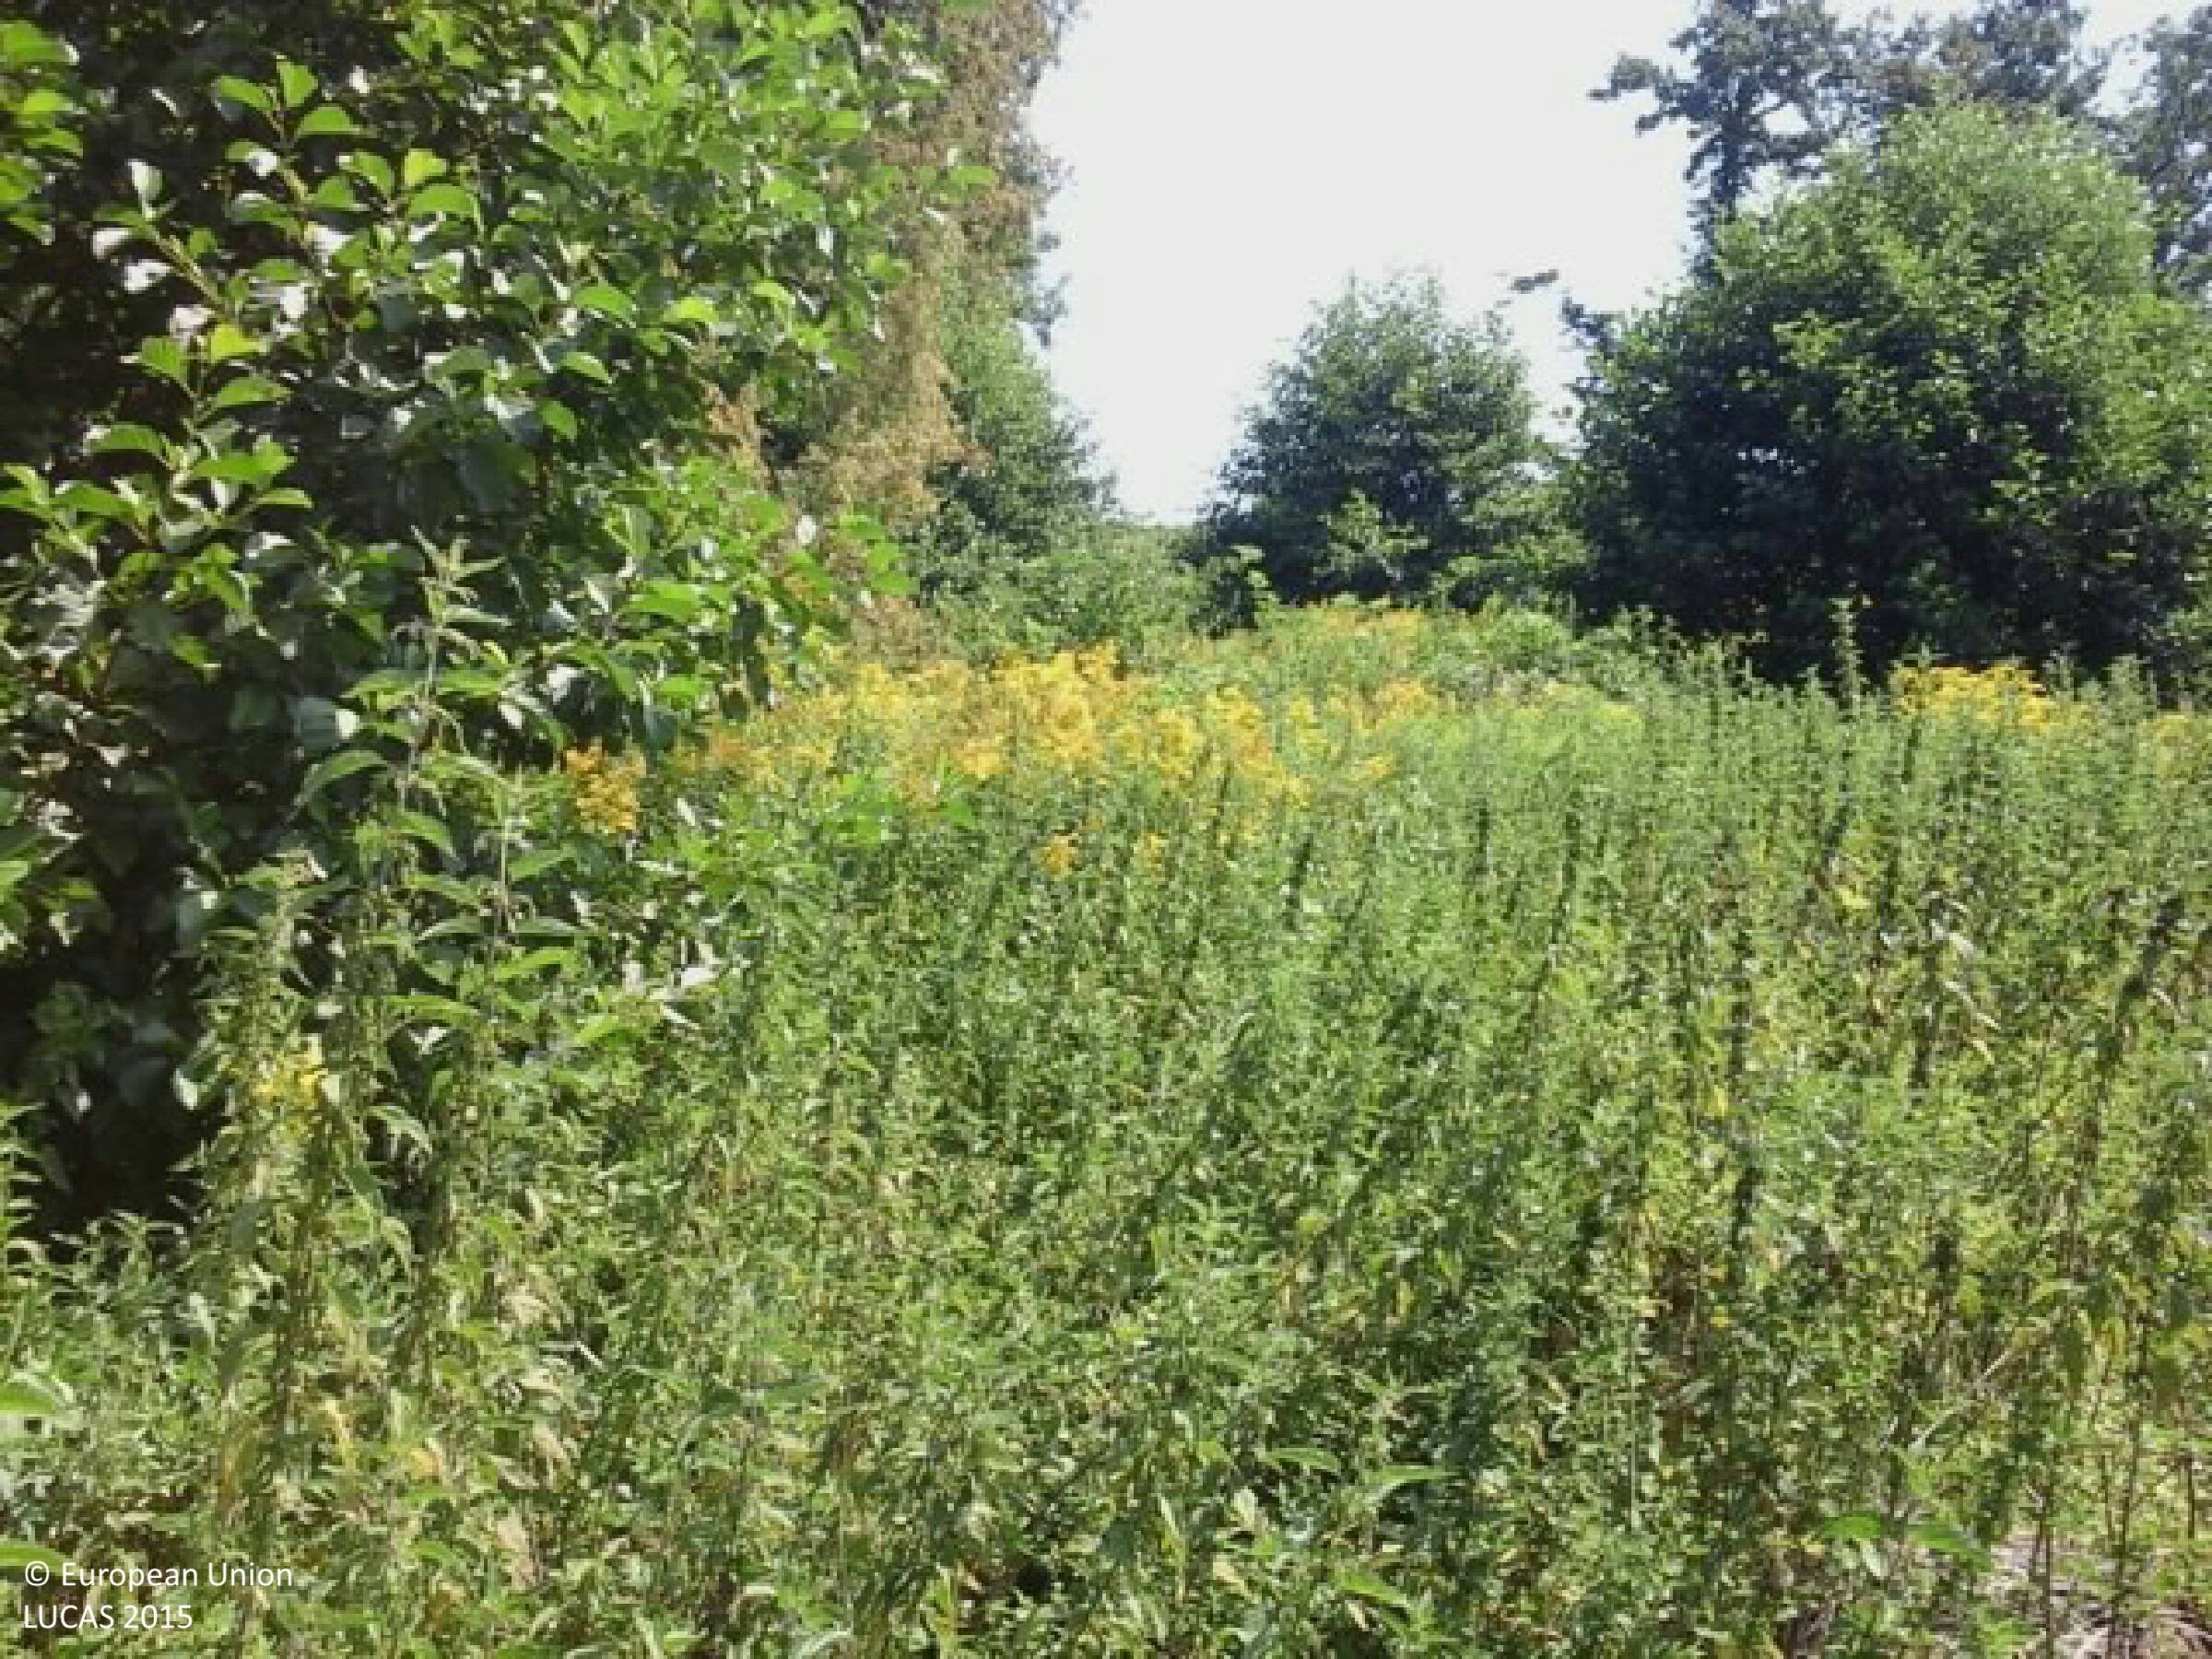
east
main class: Grassland
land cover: Spontaneously vegetated surfaces
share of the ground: > 75 %
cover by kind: herbaceous plants 95 %, shrubs 5 %
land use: Semi-natural and natural areas not in use
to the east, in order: Spontaneously vegetated surfaces; Broadleaved woodland; Grassland with sparse tree/shrub cover; Broadleaved woodland; Grass margins; Fences; Broadleaved woodland
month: August
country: HU
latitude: 46.4066
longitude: 17.0662
